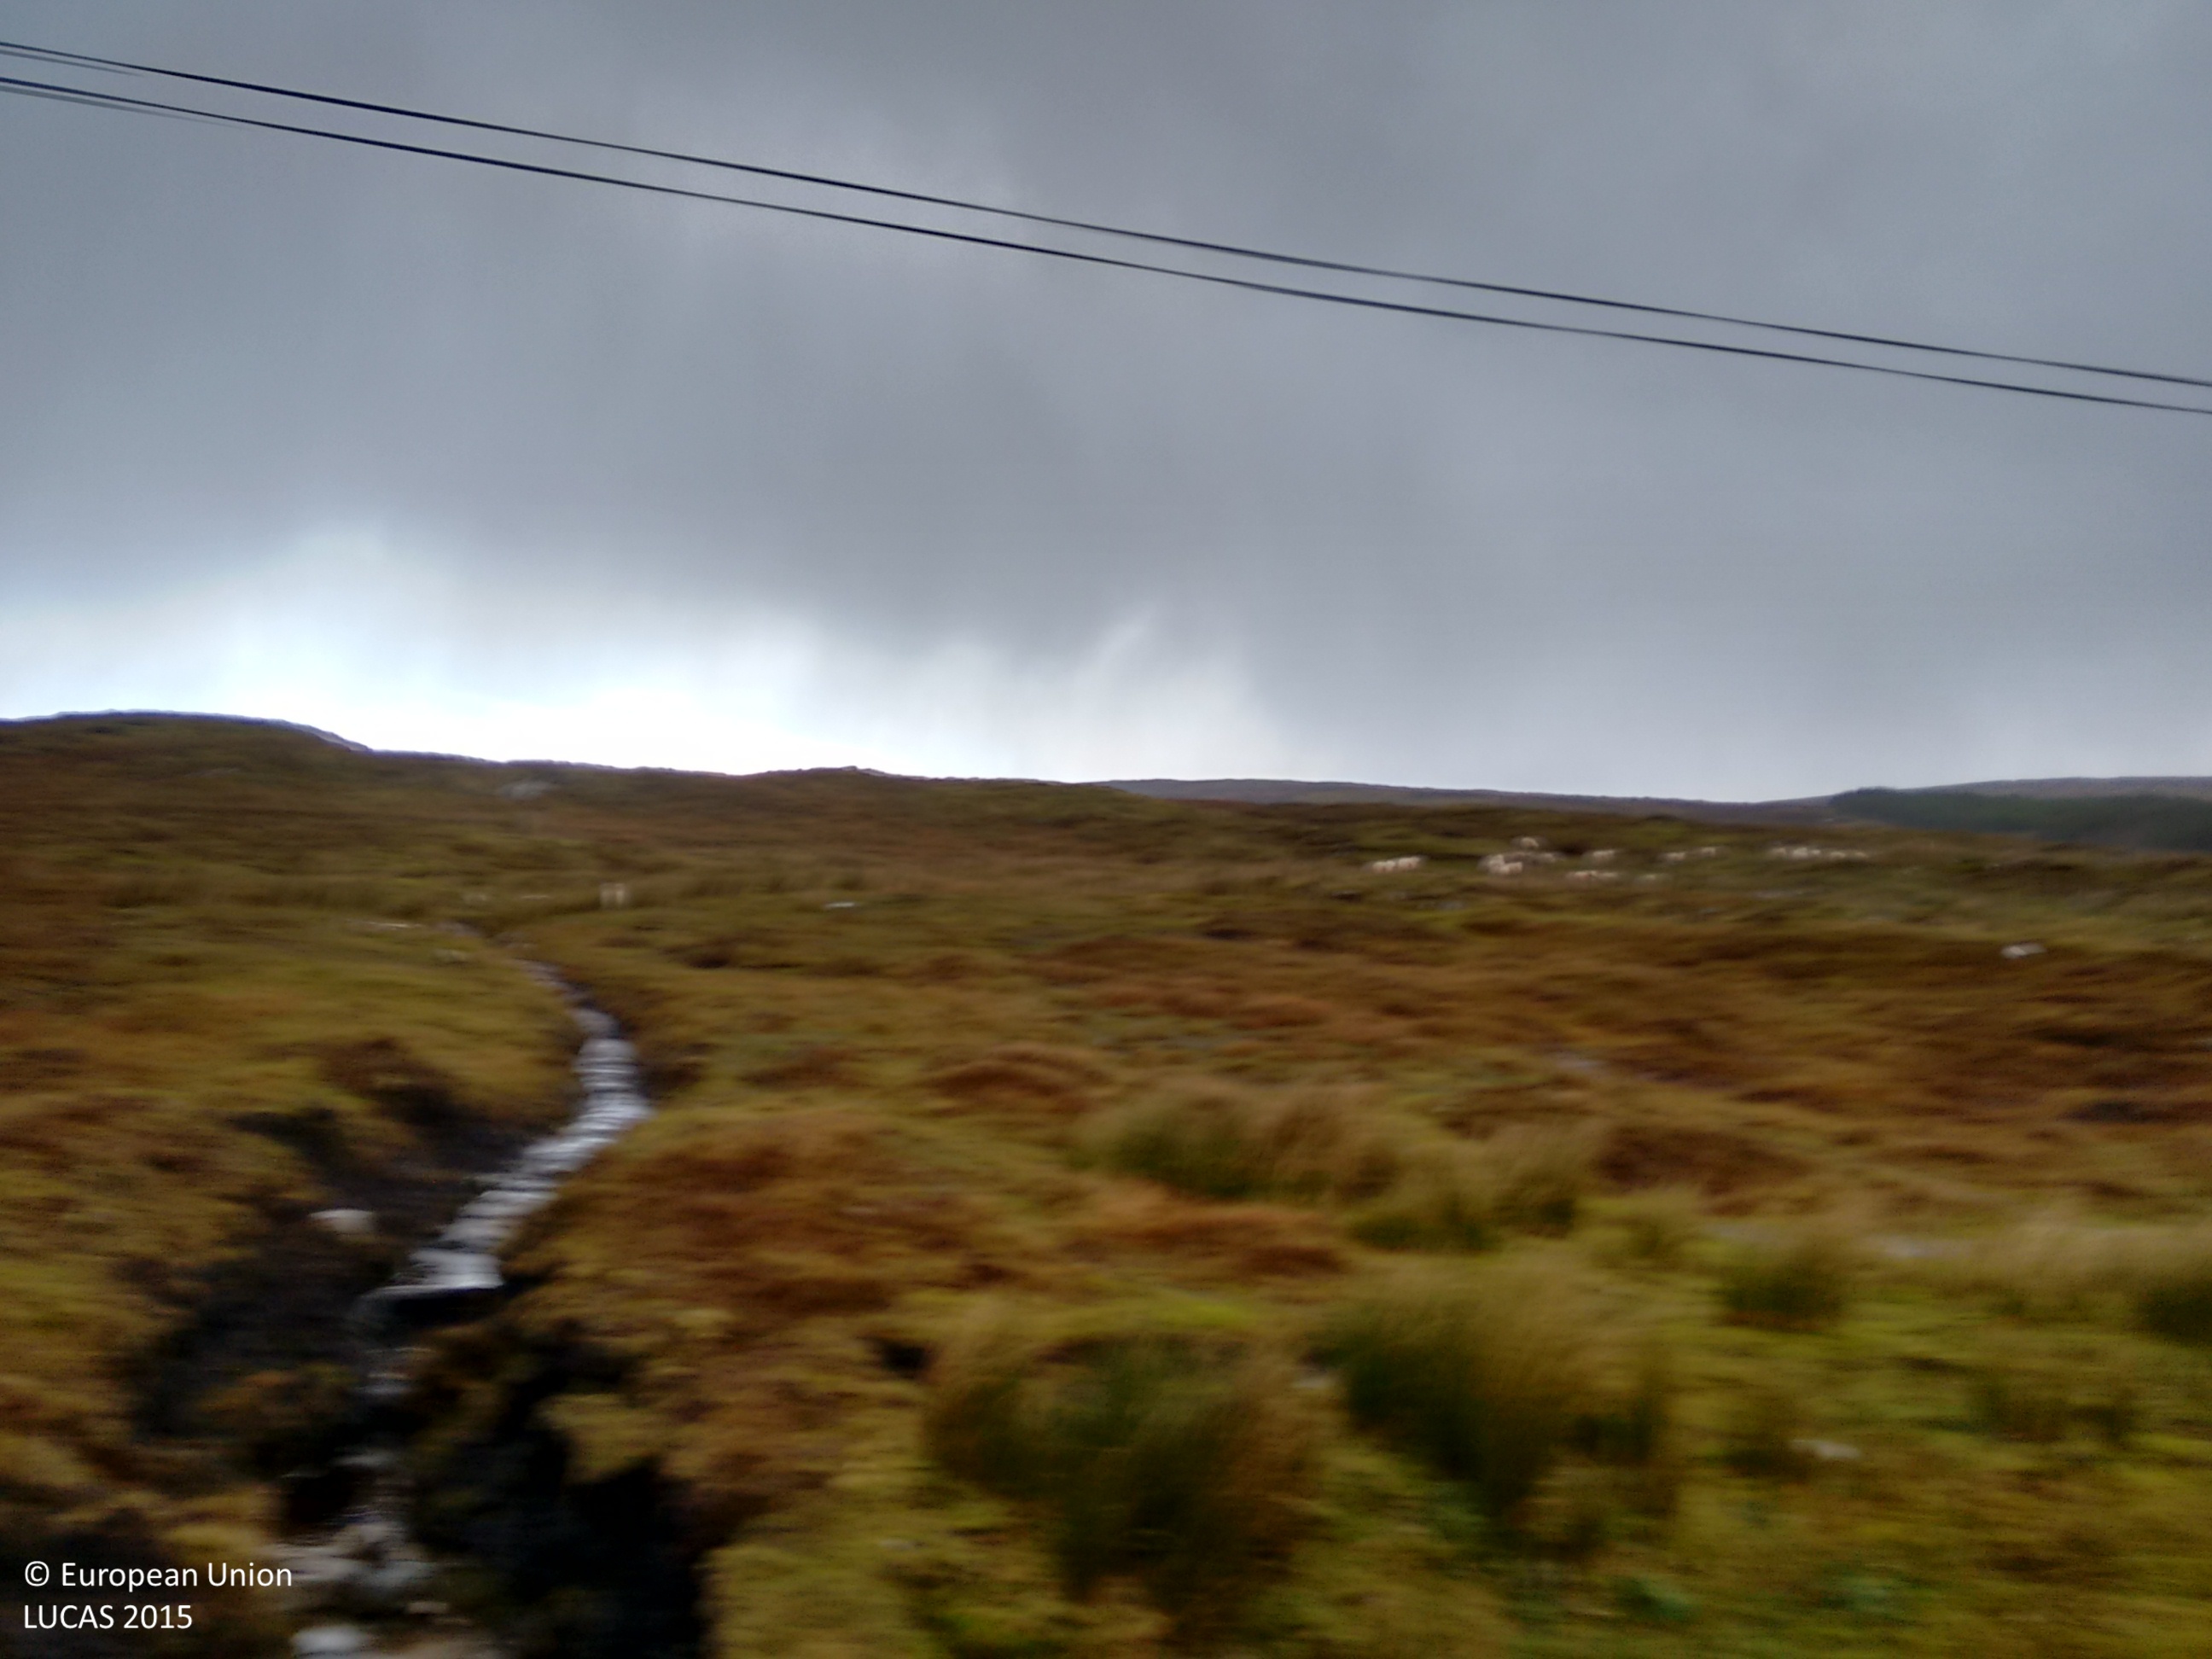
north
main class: Grassland
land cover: Grassland without tree/shrub cover
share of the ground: > 75 %
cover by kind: herbaceous plants 100 %
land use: Agriculture (excluding fallow land and kitchen gardens)
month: November
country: IE
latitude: 54.7174
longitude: -8.5898
